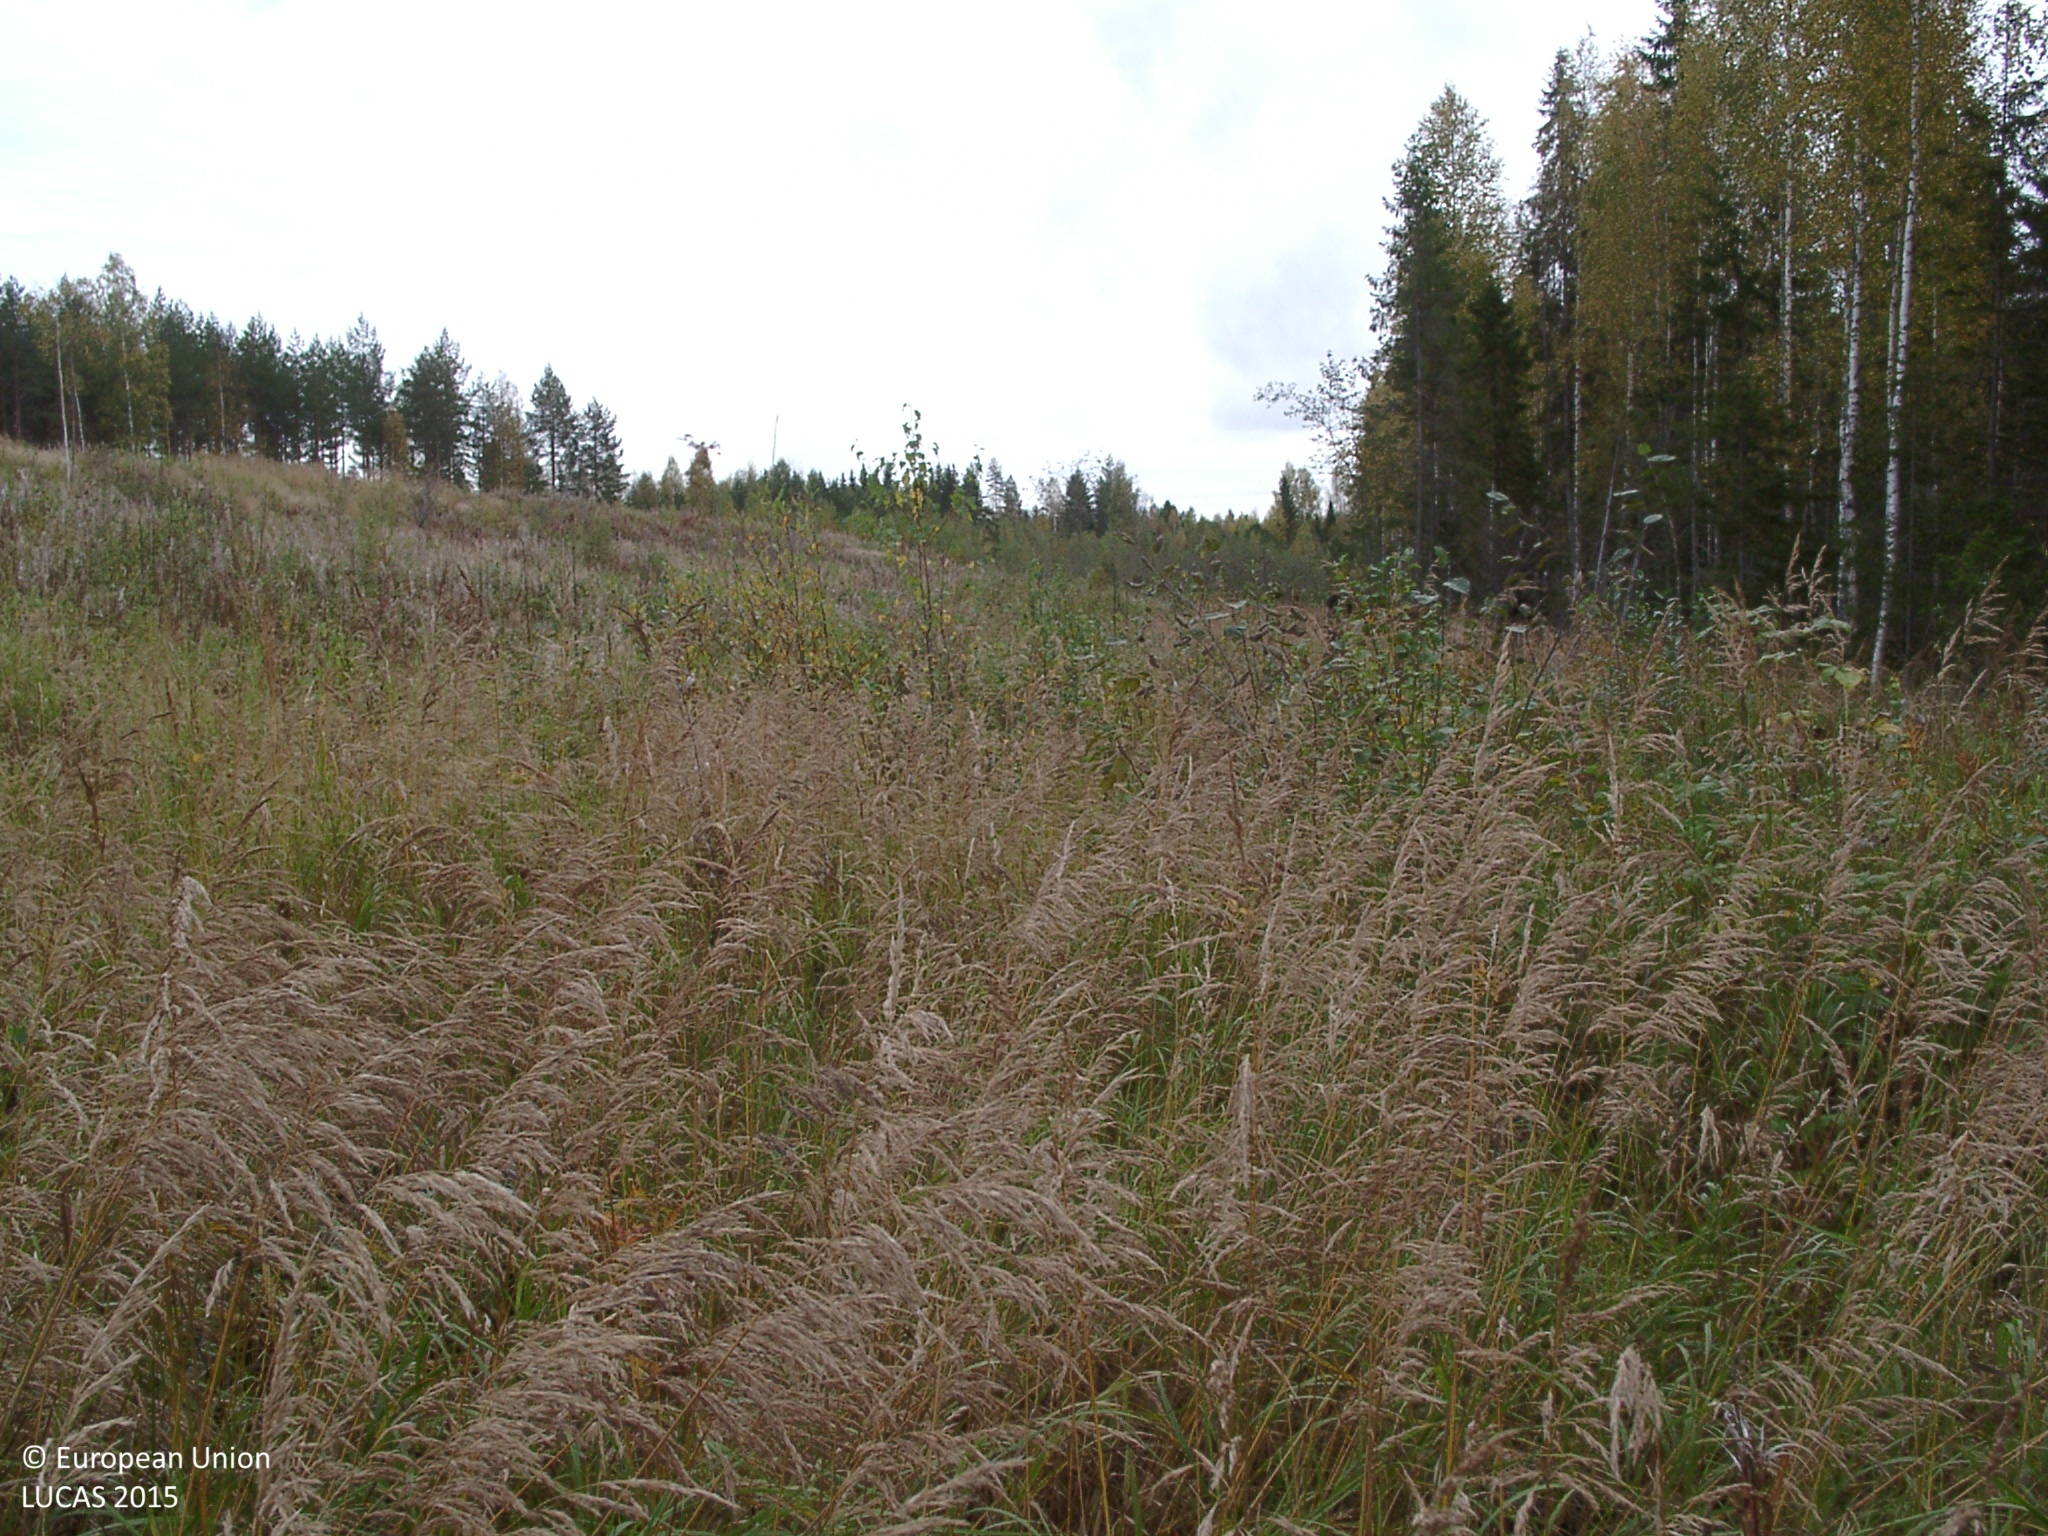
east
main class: Woodland
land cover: Broadleaved woodland
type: boreal forest
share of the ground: 10 - 25 %
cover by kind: herbaceous plants 85 %, broadleaved forest trees 10 %, shrubs 5 %
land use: Forestry
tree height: < 5 m
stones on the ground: < 10 %
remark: Clear cut
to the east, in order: Broadleaved woodland; Ditches and canals; Paved roads, cycling and walking lanes; Ditches and canals; Groves; Other coniferous woodland; Ditches and canals; Broadleaved woodland
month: September
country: FI
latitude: 62.8796
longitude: 25.7861
